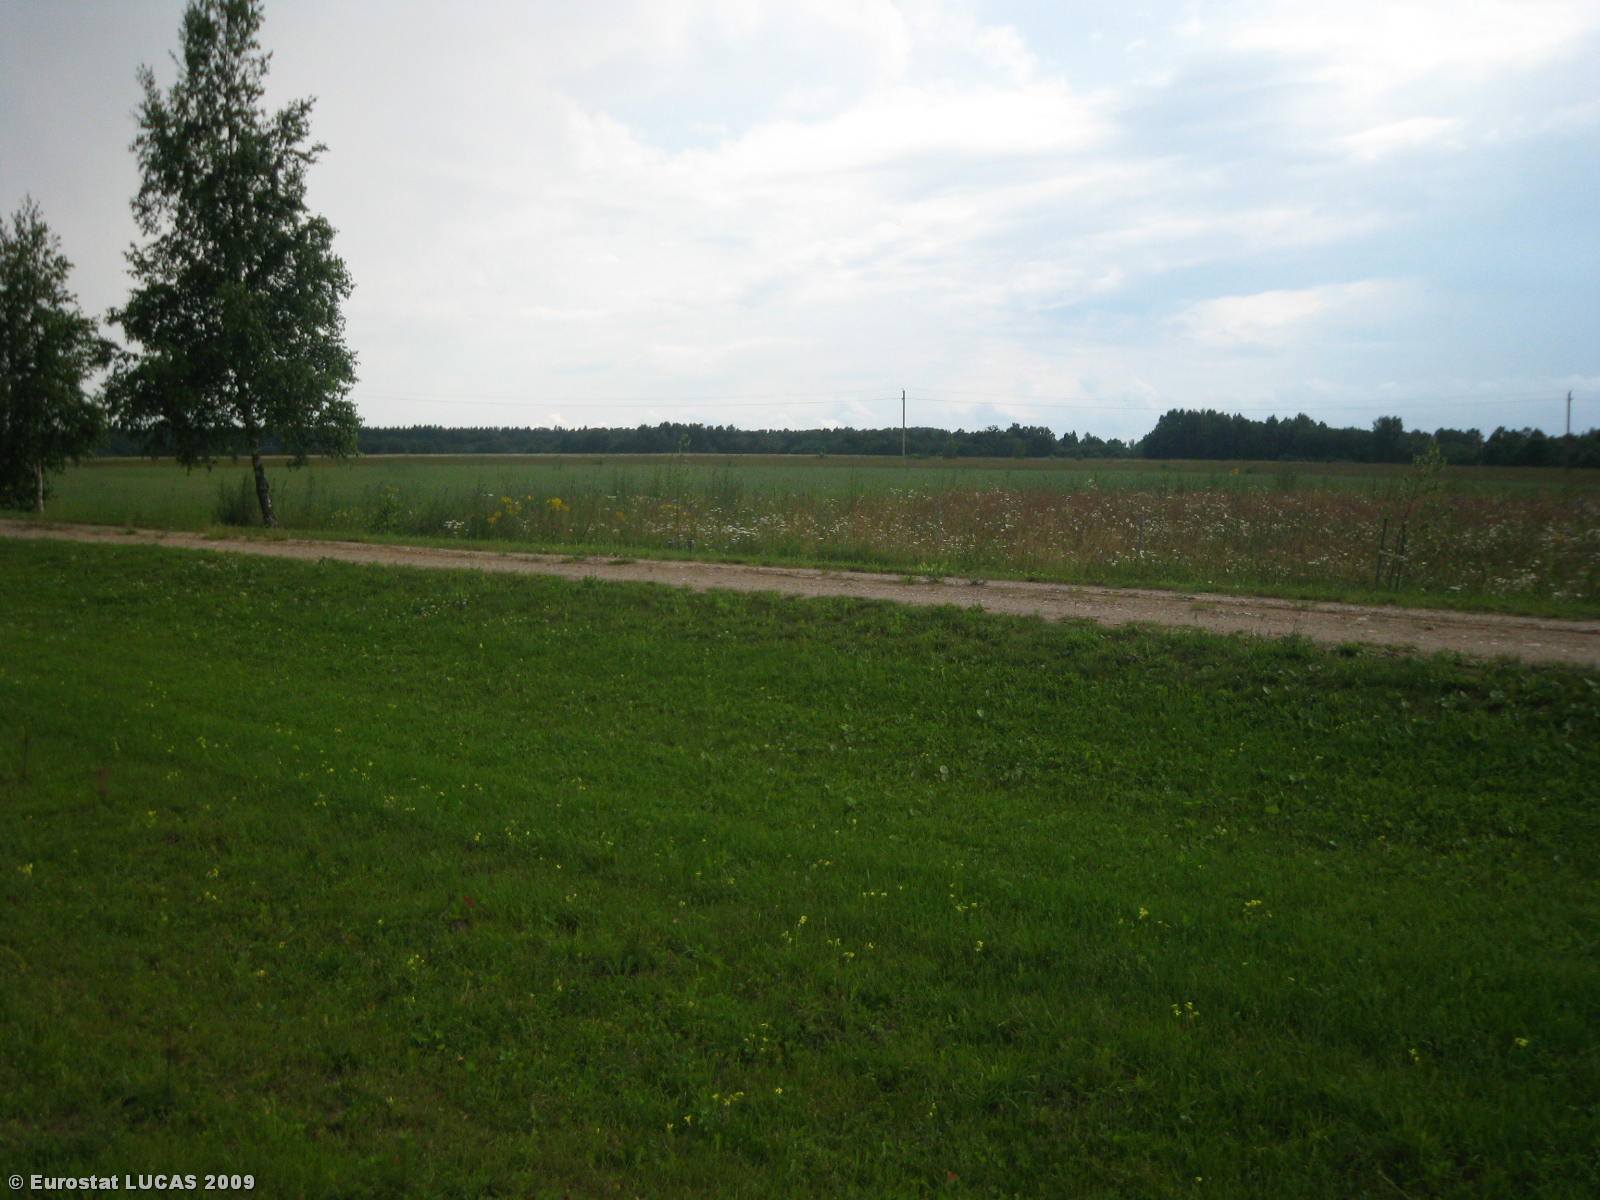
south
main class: Grassland
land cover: Grassland with sparse tree/shrub cover
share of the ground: > 75 %
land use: Forestry
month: July
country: LT
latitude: 55.2752
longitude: 24.8908
